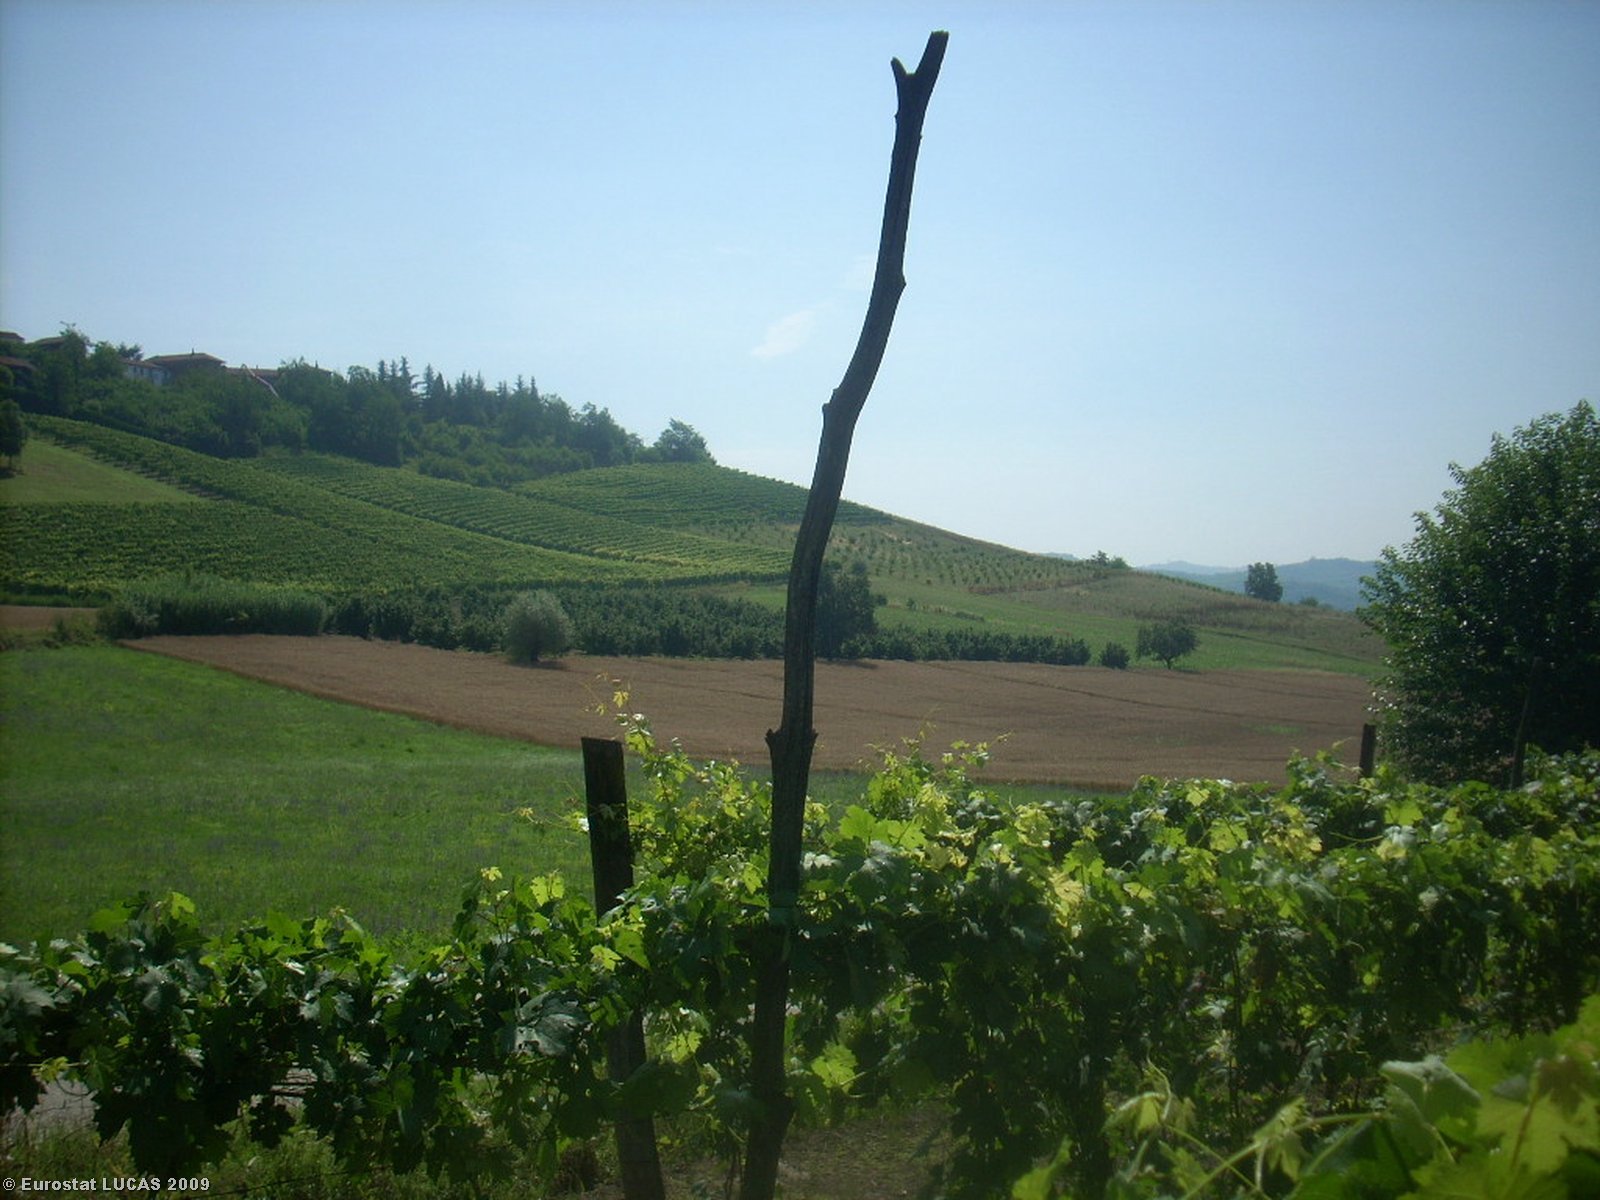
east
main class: Cropland
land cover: Vineyards
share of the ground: < 10 %
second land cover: Grassland with sparse tree/shrub cover
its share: < 10 %
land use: Agriculture (excluding fallow land and kitchen gardens)
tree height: < 5 m
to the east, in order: Vineyards; Grassland with sparse tree/shrub cover; Ditches and canals; Grass margins; Paved roads, cycling and walking lanes; Grassland without tree/shrub cover; Common wheat; Grass margins; Nuts trees; Grassland with sparse tree/shrub cover; Vineyards; Grassland with sparse tree/shrub cover
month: July
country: IT
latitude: 44.8021
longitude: 8.0947
